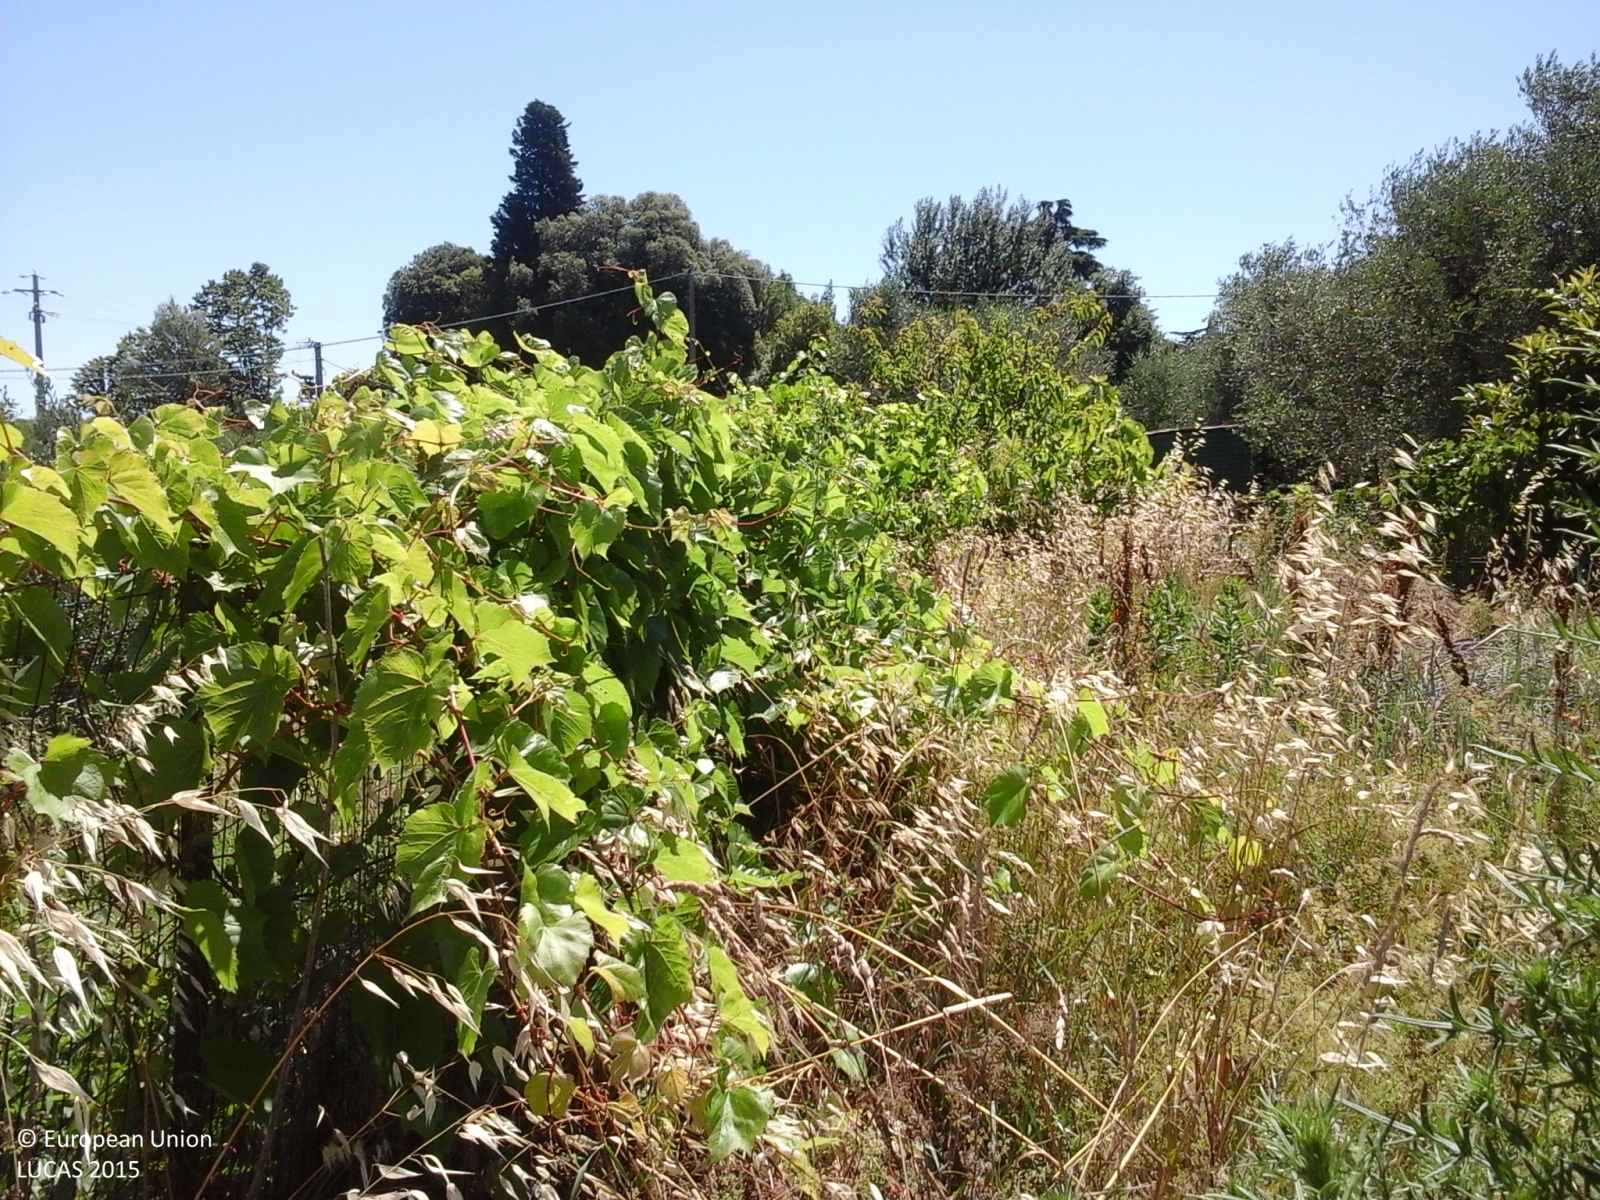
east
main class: Grassland
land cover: Grassland without tree/shrub cover
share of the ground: > 75 %
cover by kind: herbaceous plants 100 %
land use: Agriculture (excluding fallow land and kitchen gardens)
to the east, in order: Grassland without tree/shrub cover; Electric lines; Grassland without tree/shrub cover; Electric lines; Ditches and canals; Olive groves; Managed hedges; Olive groves; Fences; Grassland without tree/shrub cover; Fences; Grassland without tree/shrub cover; Abandoned hedges
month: June
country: IT
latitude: 43.7857
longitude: 11.0783
